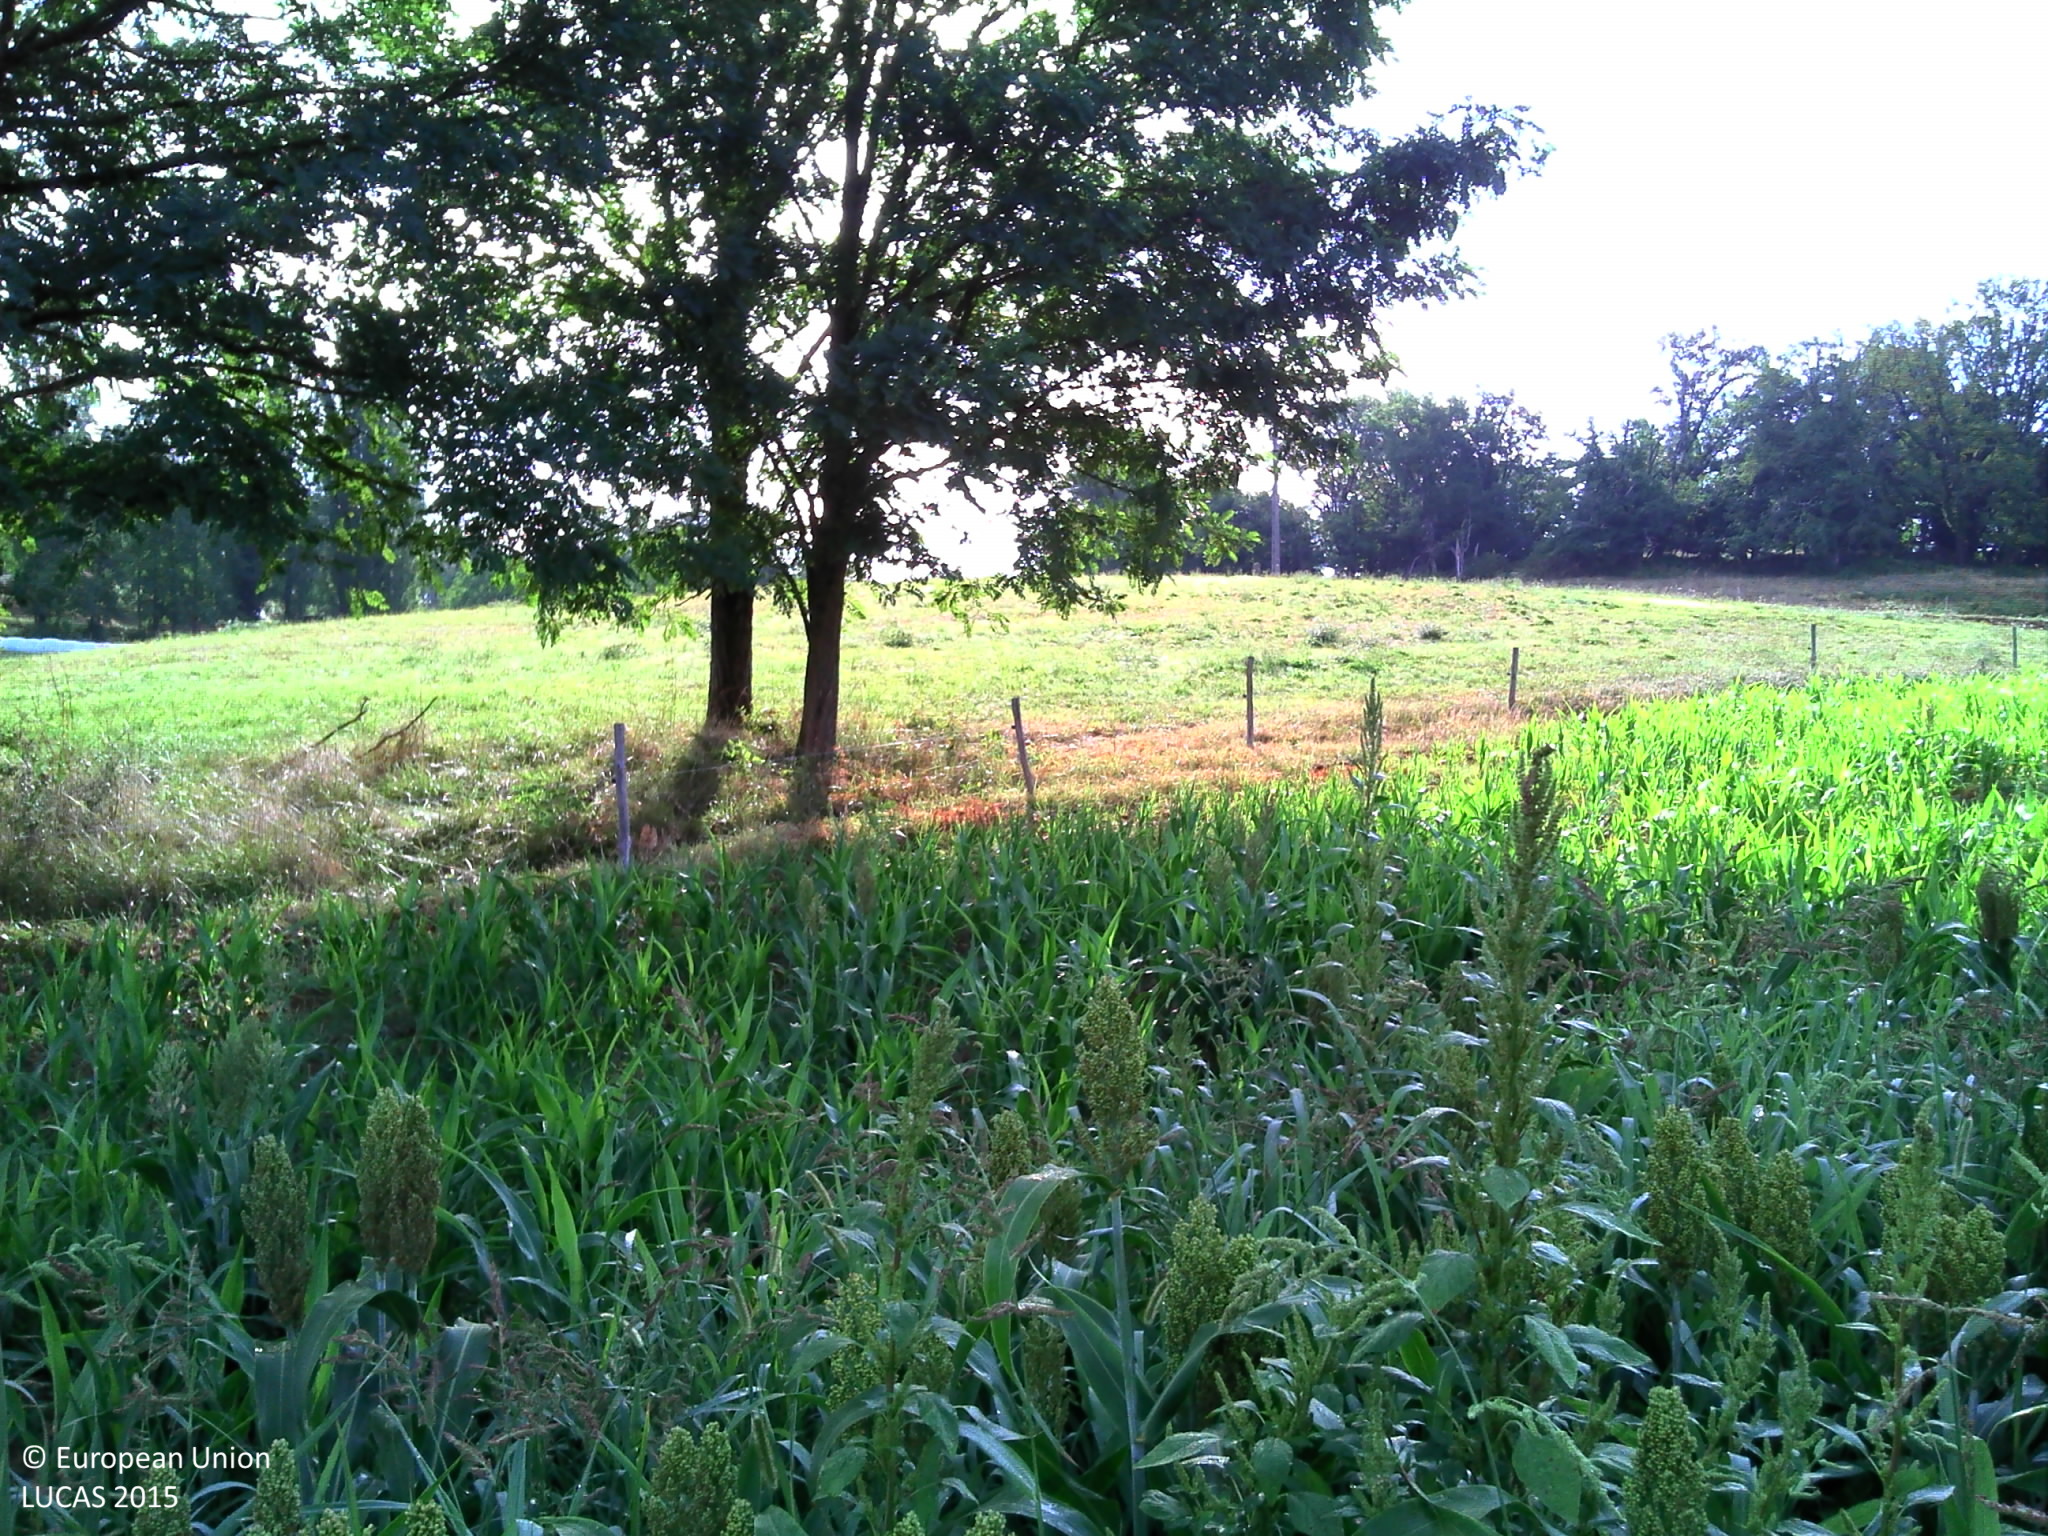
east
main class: Cropland
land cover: Other cereals
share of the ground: > 75 %
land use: Agriculture (excluding fallow land and kitchen gardens)
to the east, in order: Other cereals; Fences; Single bushes/trees; Grassland without tree/shrub cover; Electric lines; Grassland without tree/shrub cover; Tracks; Ditches and canals; Fences; Grassland without tree/shrub cover
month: July
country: FR
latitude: 44.9675
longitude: 1.1315
